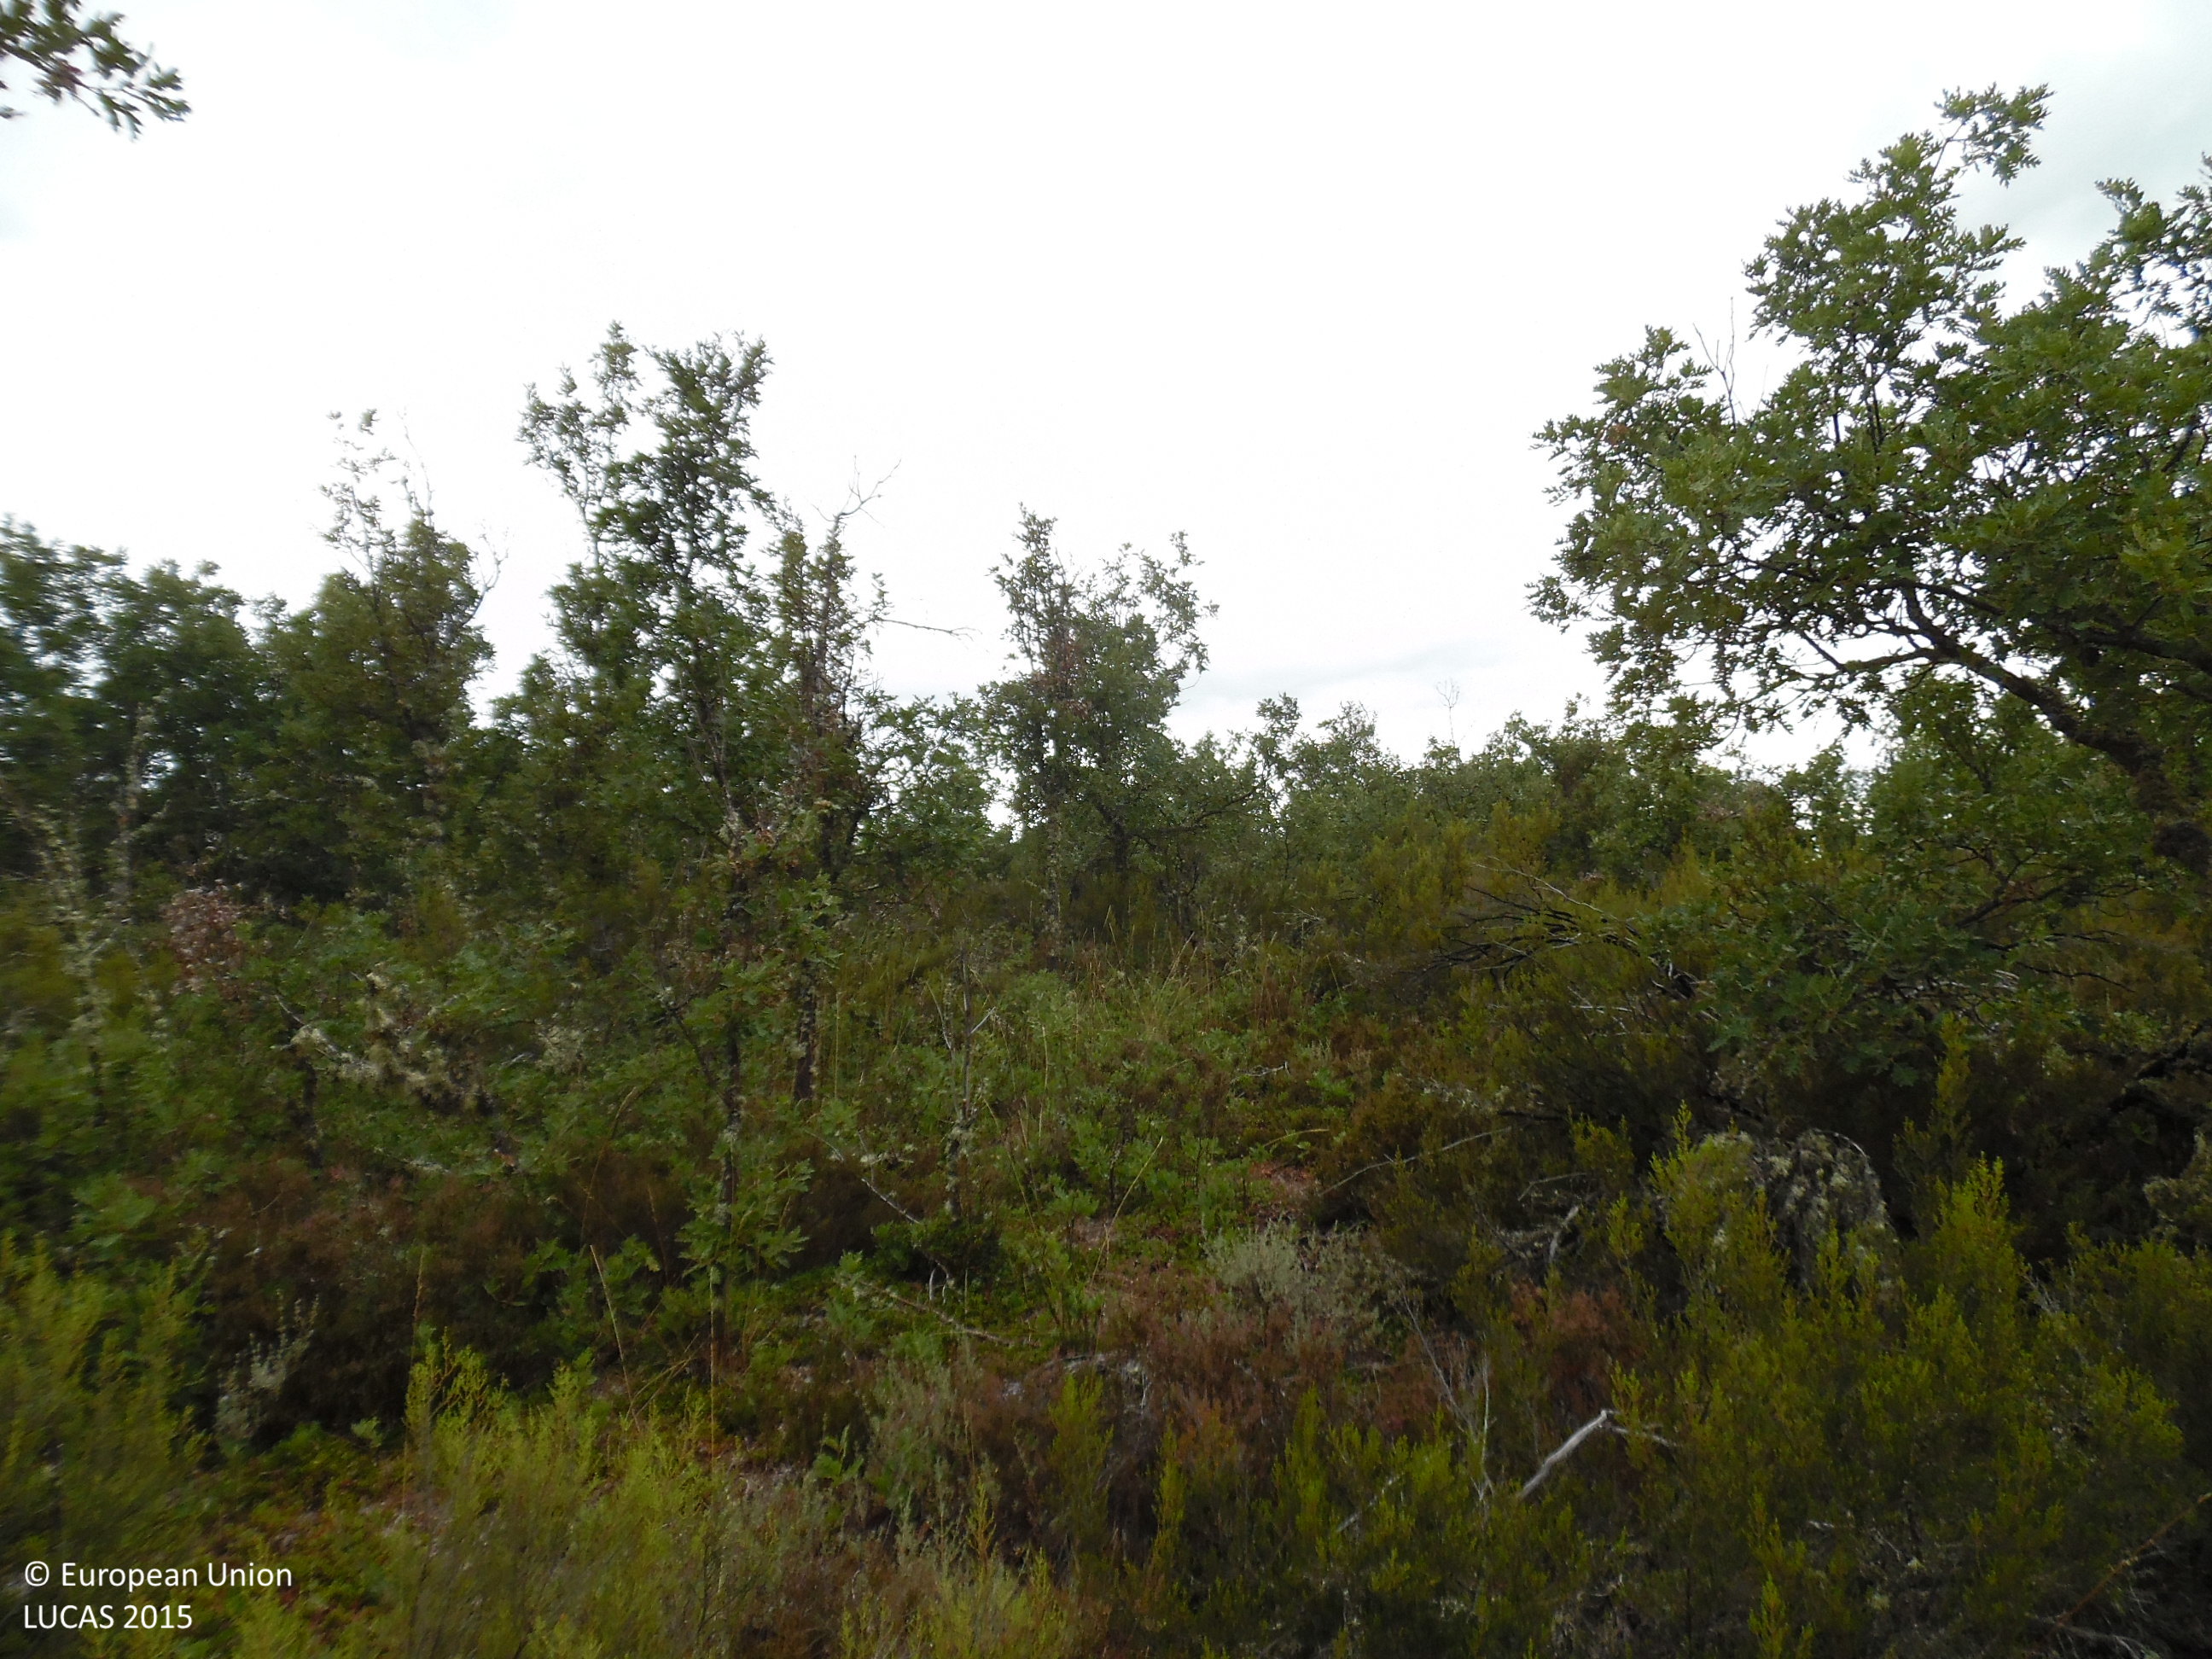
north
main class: Woodland
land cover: Broadleaved woodland
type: broadleaved evergreen forest
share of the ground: > 75 %
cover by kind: broadleaved forest trees 90 %, shrubs 10 %
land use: Forestry
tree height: > 5 m
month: July
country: ES
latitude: 42.6256
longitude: -5.7447
